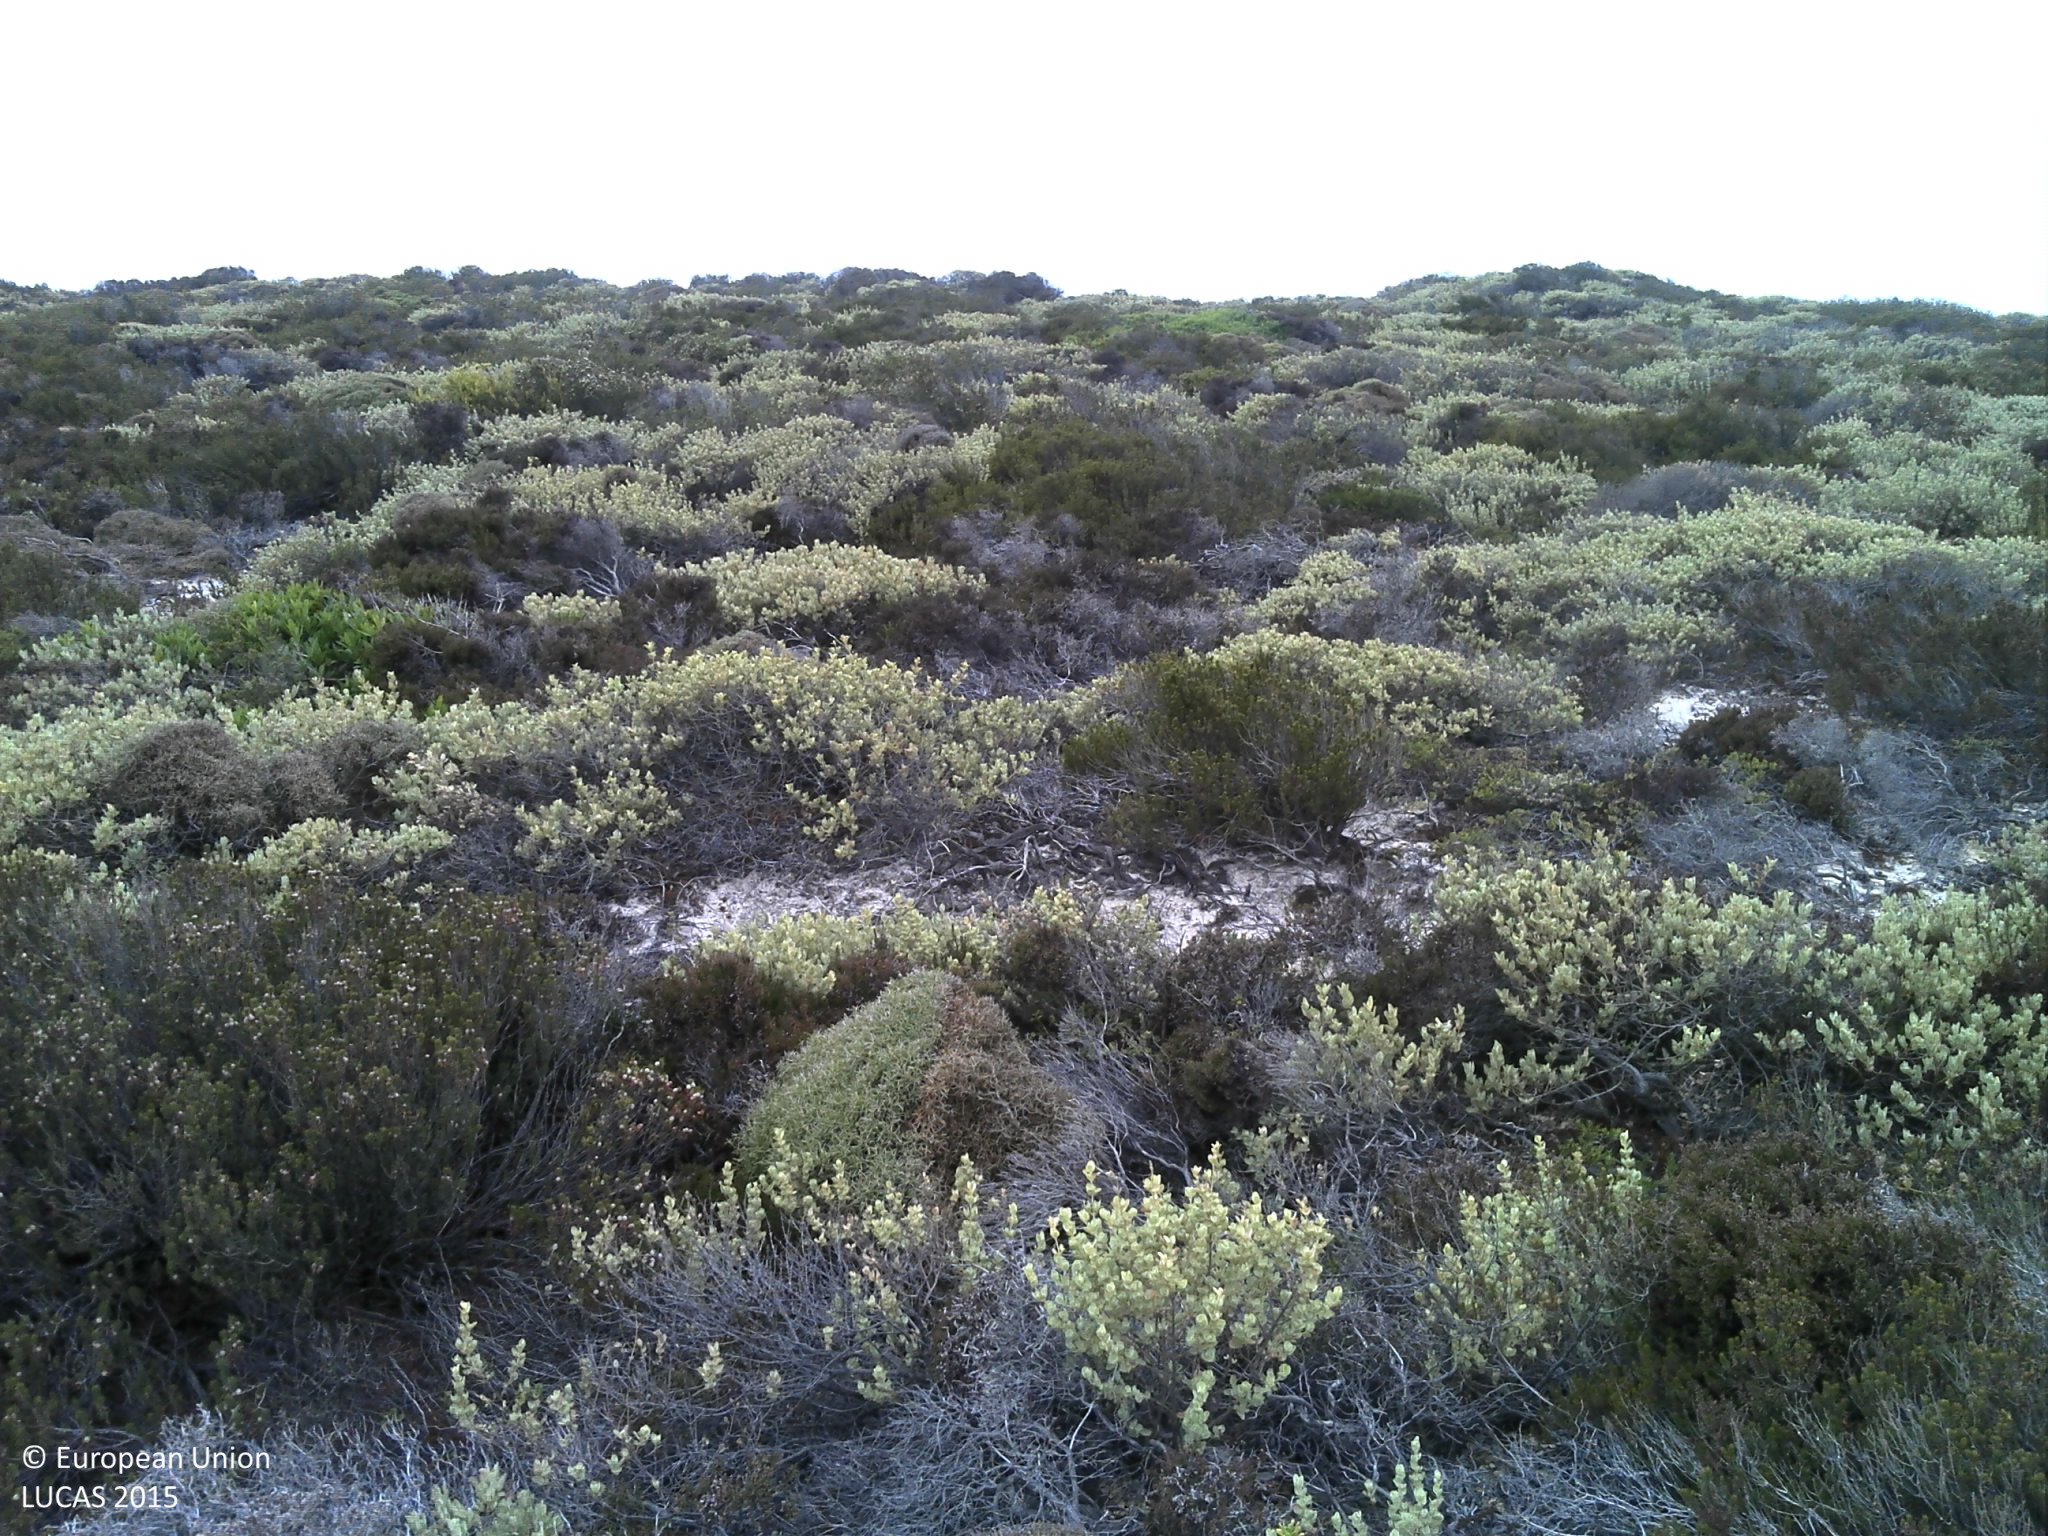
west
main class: Shrubland
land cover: Shrubland without tree cover
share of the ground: 50 - 75 %
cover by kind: shrubs 60 %, herbaceous plants 20 %, unconsolidated bare surface 20 %
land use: Abandoned areas
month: July
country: PT
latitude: 37.0640
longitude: -8.9623
